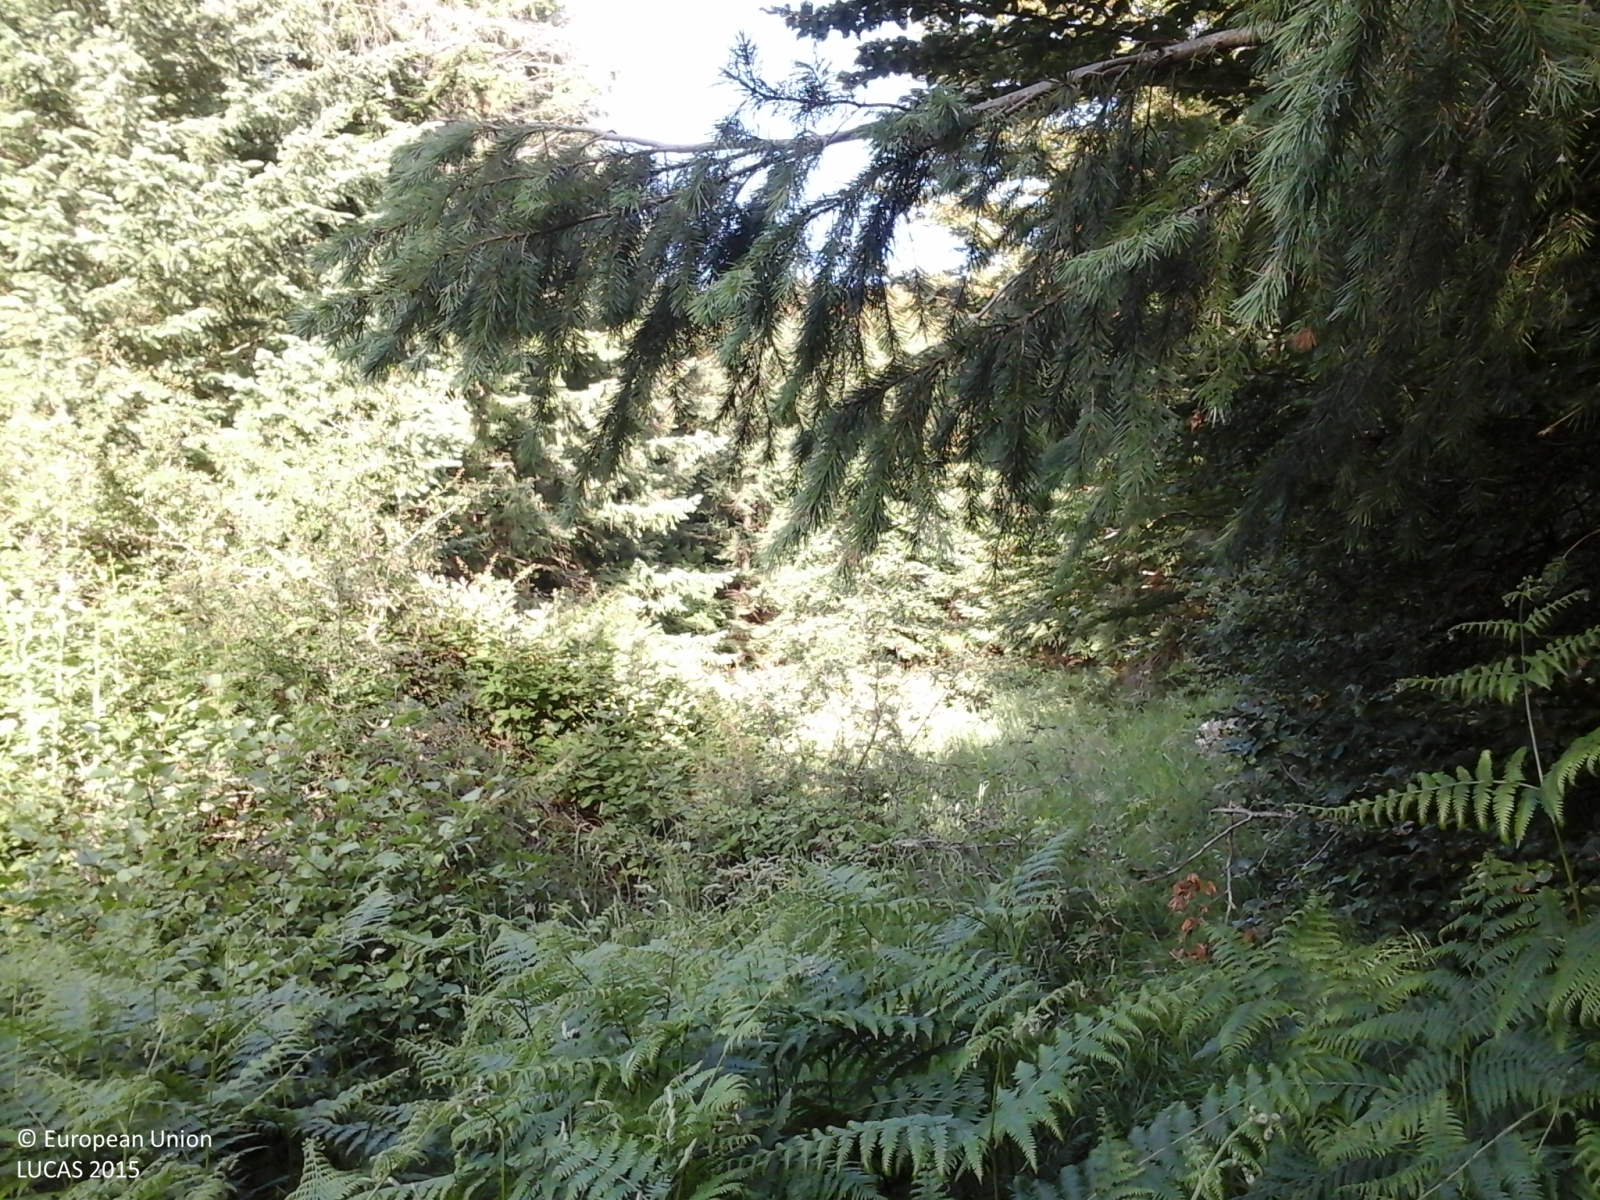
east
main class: Grassland
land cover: Grassland without tree/shrub cover
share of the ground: > 75 %
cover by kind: herbaceous plants 95 %, shrubs 5 %
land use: Agriculture (excluding fallow land and kitchen gardens)
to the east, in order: Grassland without tree/shrub cover; Ditches and canals; Grassland without tree/shrub cover; Spruce dominated coniferous woodland; Broadleaved woodland; Tracks; Broadleaved woodland; Tracks; Broadleaved woodland; Ditches and canals; Broadleaved woodland
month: June
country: IT
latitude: 43.8860
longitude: 11.6762
